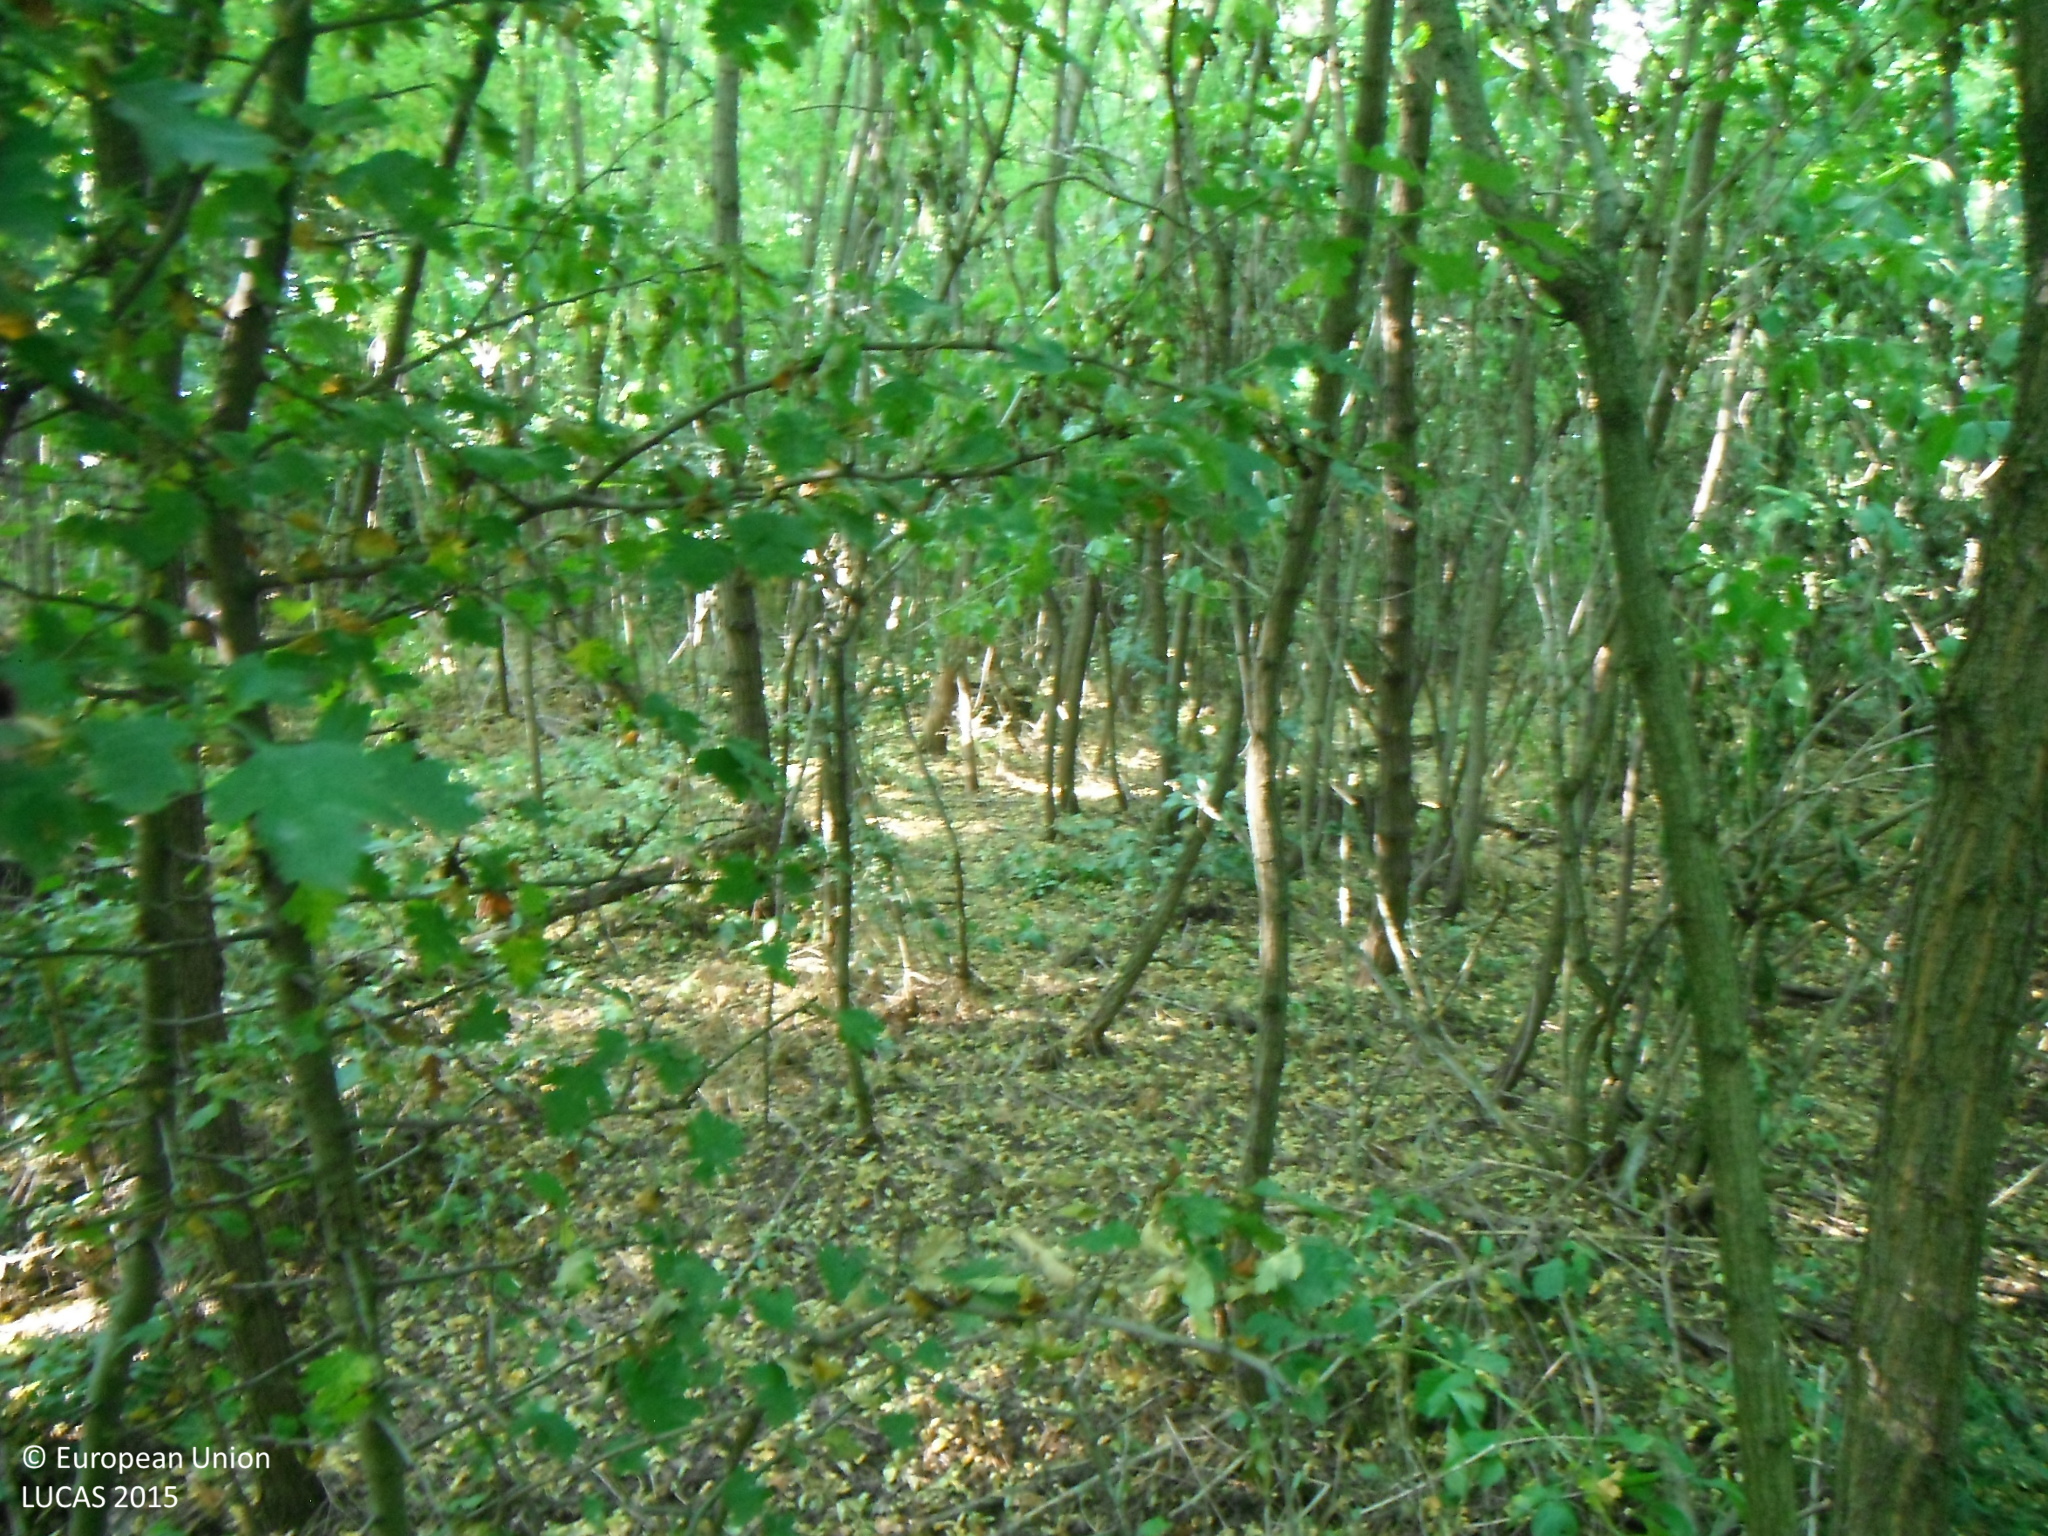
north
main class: Woodland
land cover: Broadleaved woodland
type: exotic forest
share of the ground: > 75 %
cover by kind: broadleaved forest trees 90 %, shrubs 10 %
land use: Forestry
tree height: > 5 m
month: July
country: SK
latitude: 48.1392
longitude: 19.2811
